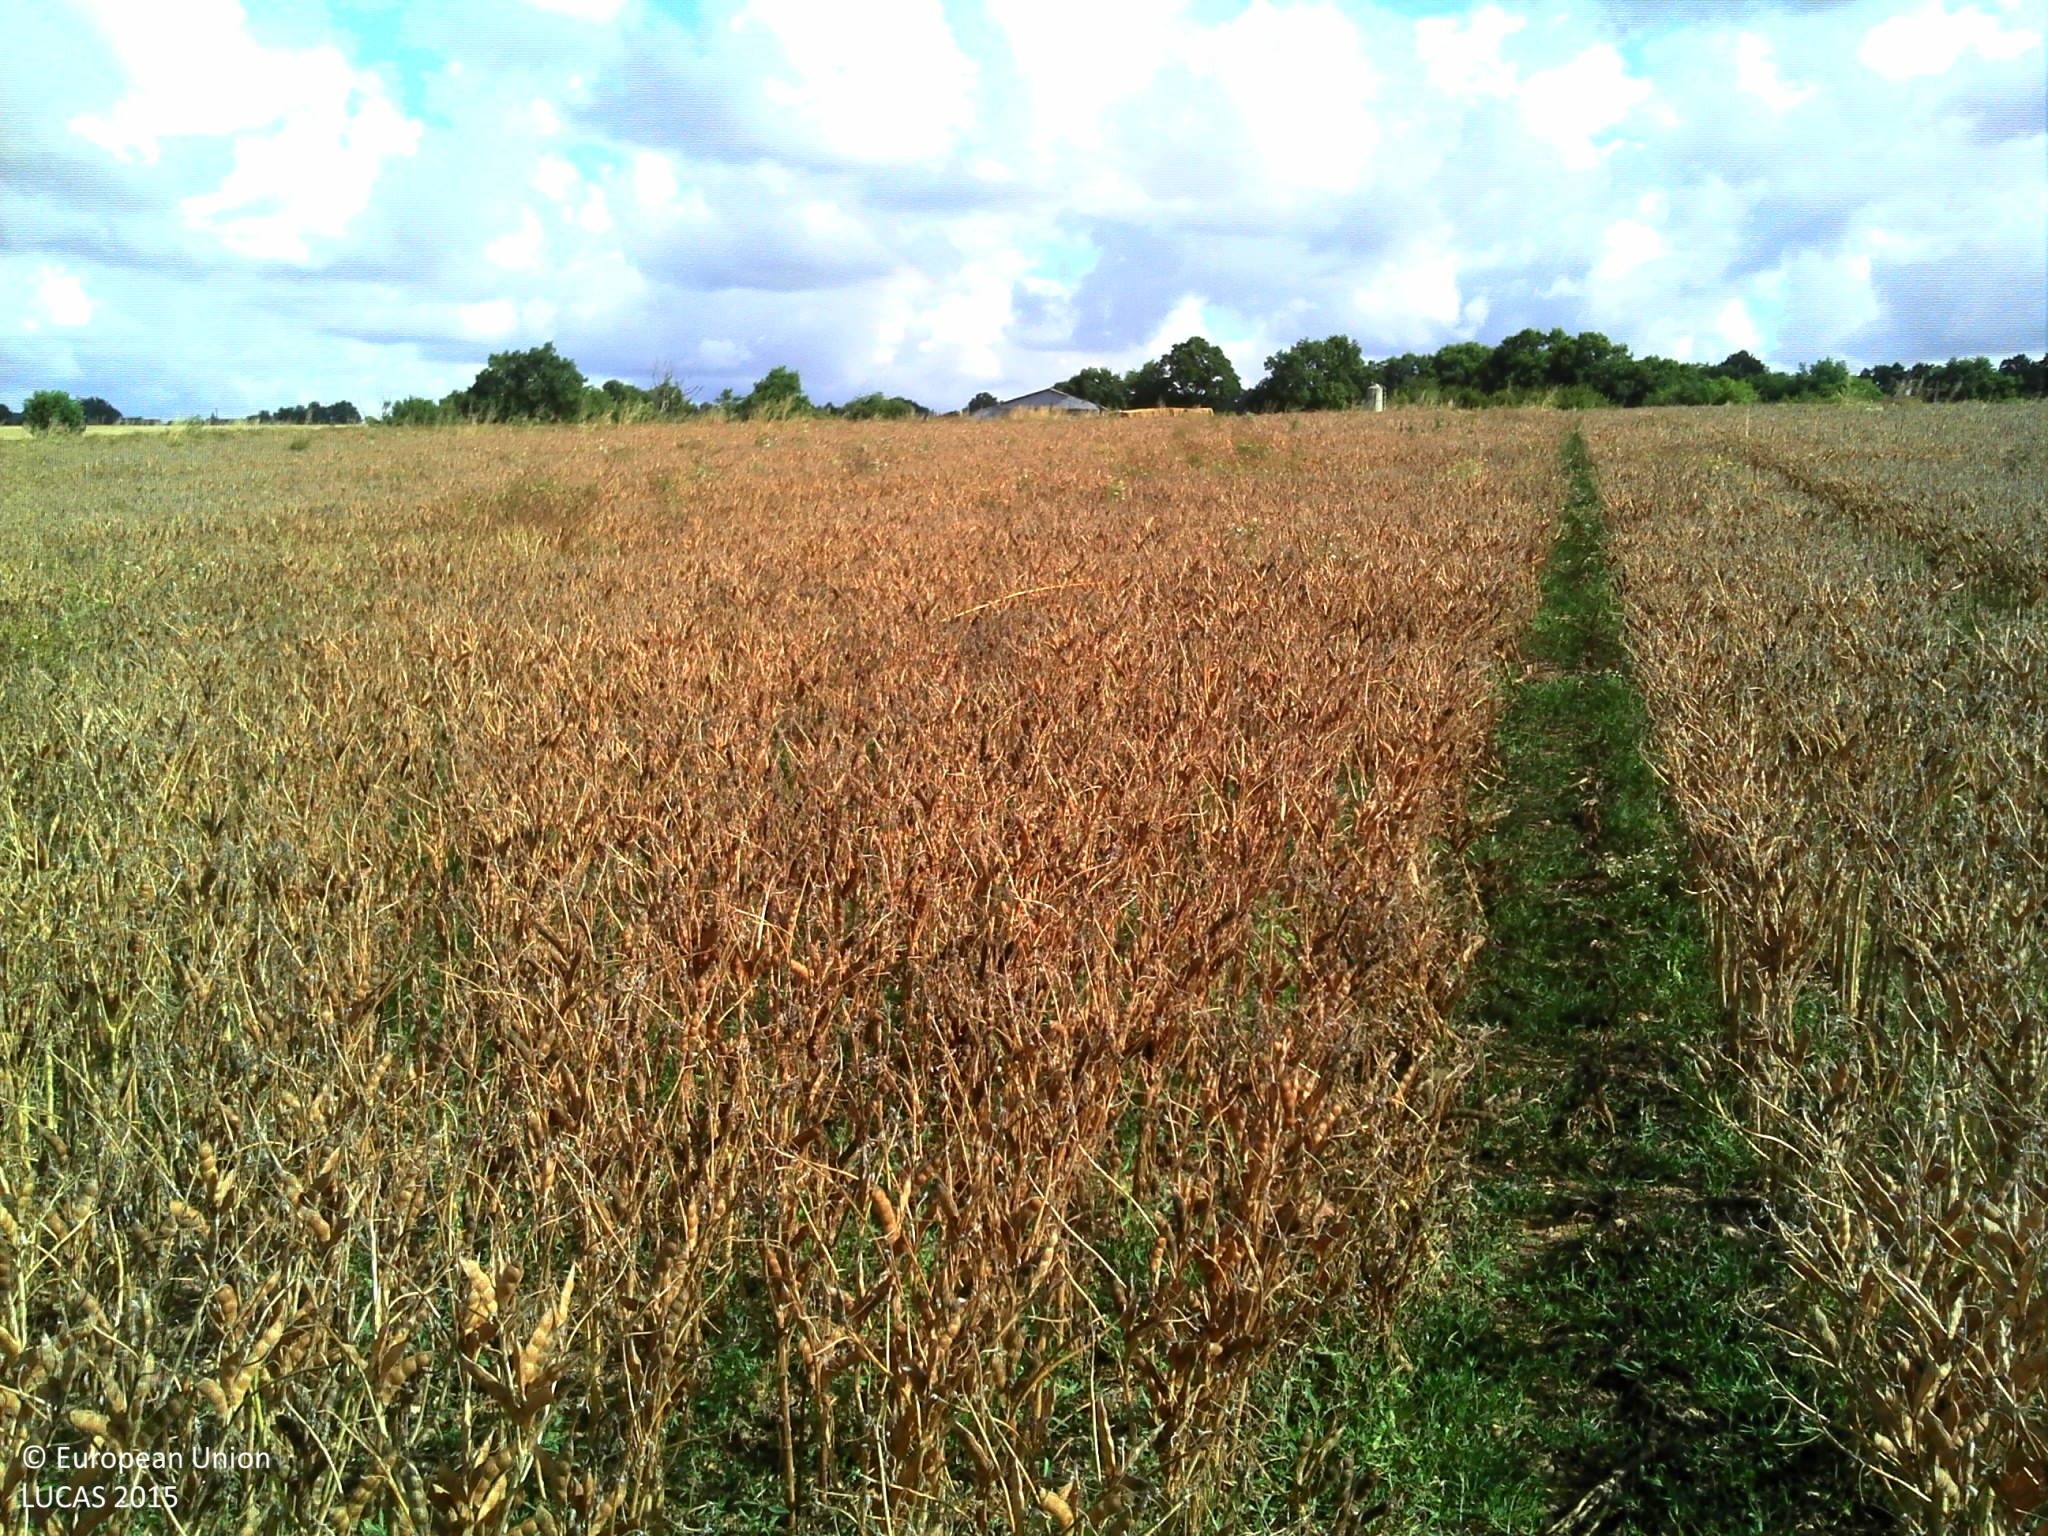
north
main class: Cropland
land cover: Dry pulses
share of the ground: > 75 %
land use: Agriculture (excluding fallow land and kitchen gardens)
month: July
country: FR
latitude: 47.6943
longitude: -1.6512
